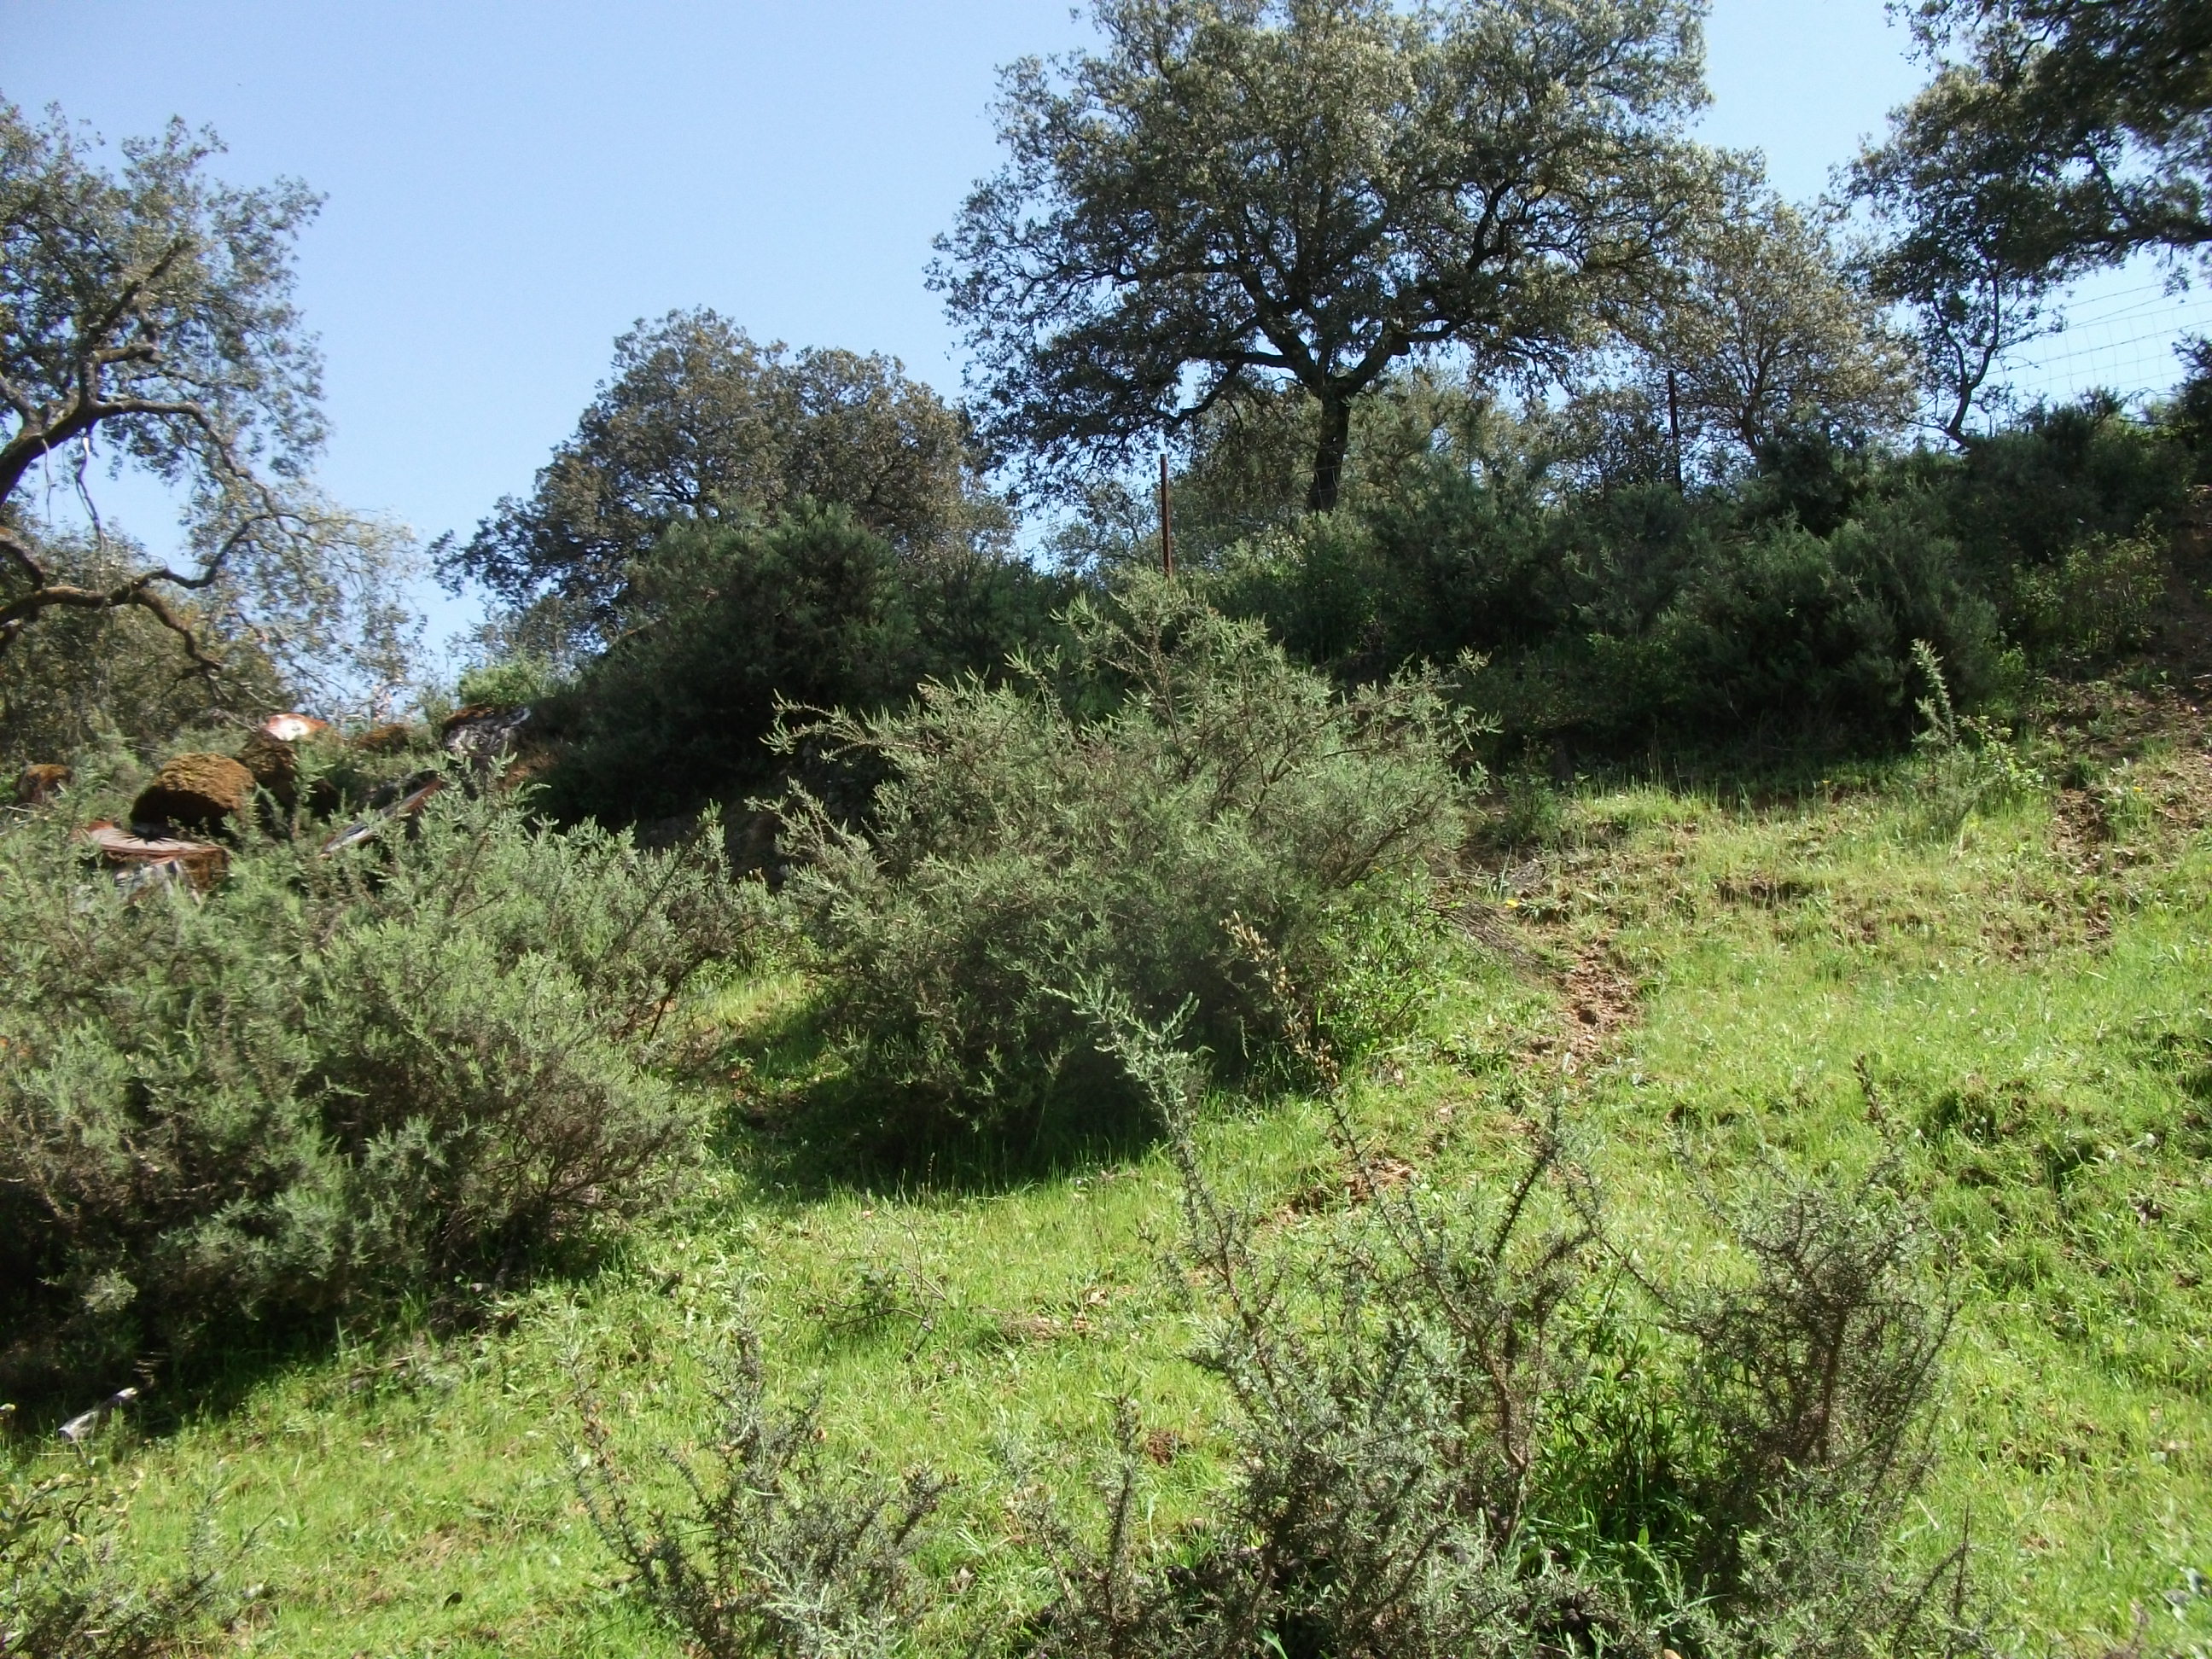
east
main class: Woodland
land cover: Broadleaved woodland
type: broadleaved evergreen forest
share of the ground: 50 - 75 %
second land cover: Shrubland without tree cover
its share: 50 - 75 %
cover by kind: broadleaved forest trees 60 %, shrubs 35 %, herbaceous plants 5 %
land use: Forestry
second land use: Agriculture (excluding fallow land and kitchen gardens)
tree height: > 5 m
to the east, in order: Broadleaved woodland; Shrubland without tree cover; Fences; Broadleaved woodland
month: April
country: ES
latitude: 37.9639
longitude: -6.7694
